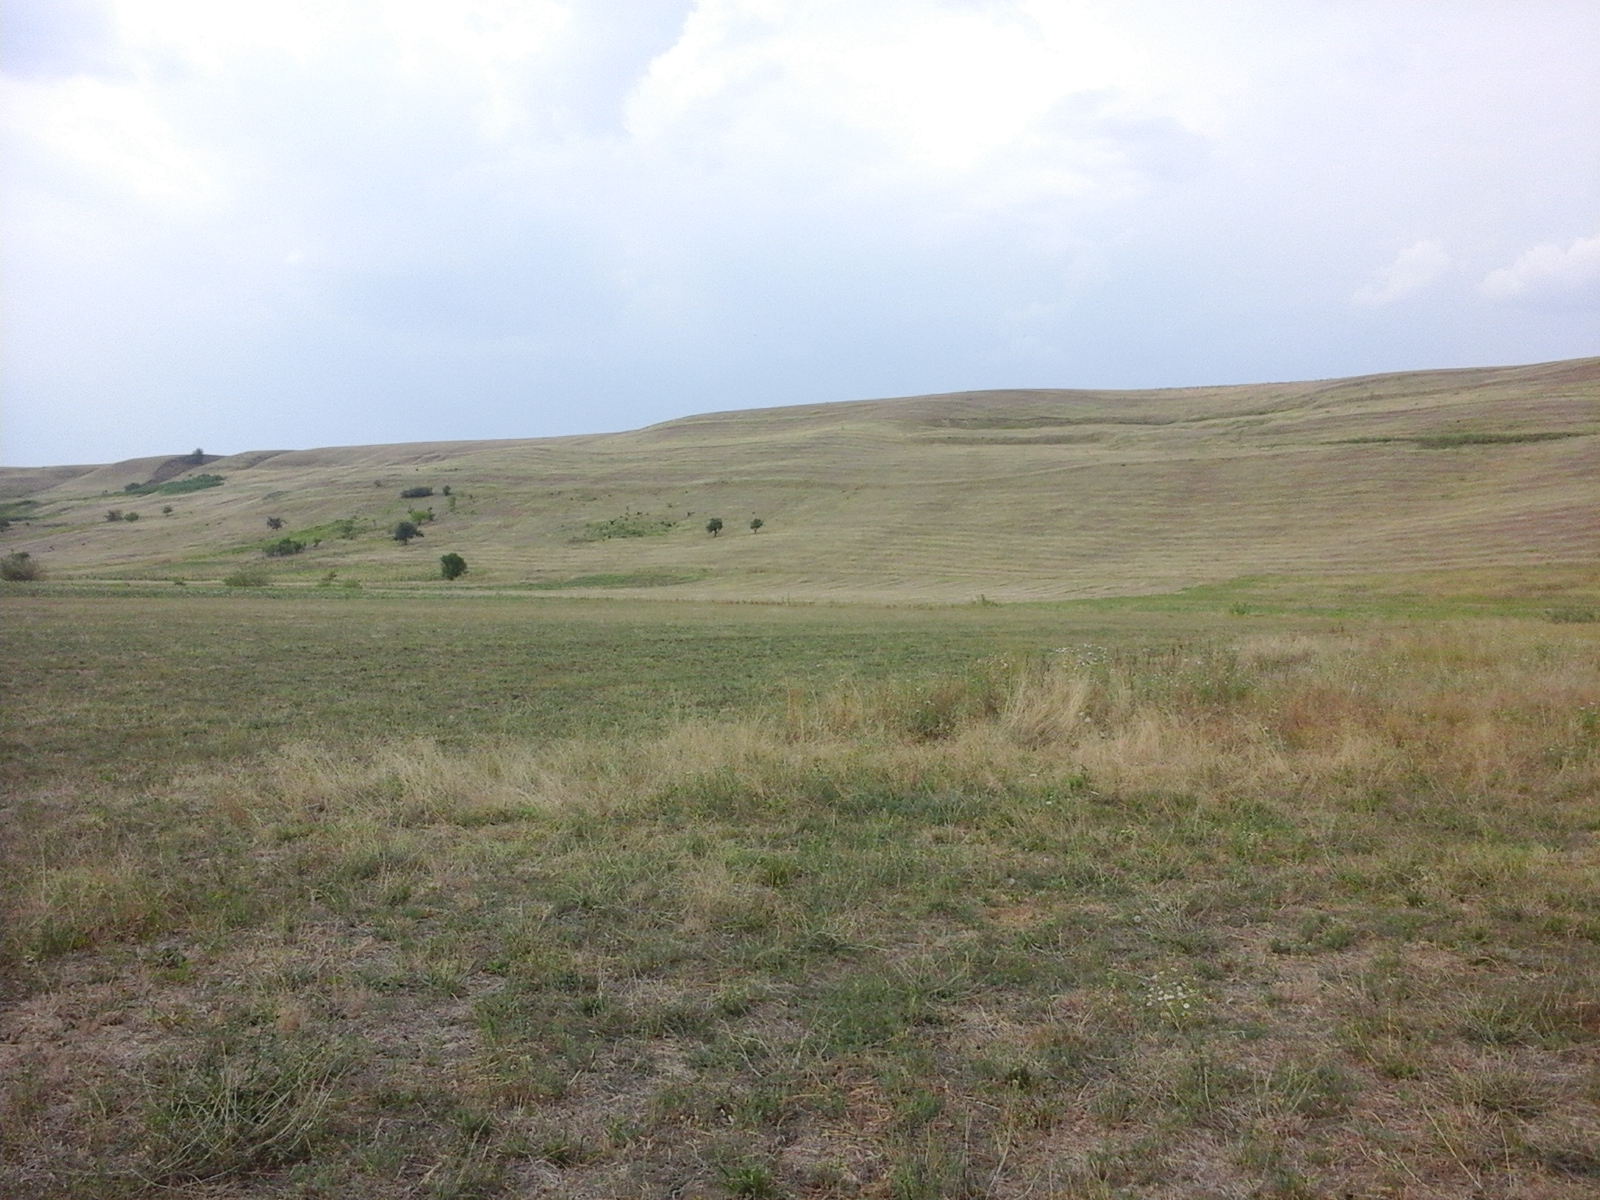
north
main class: Grassland
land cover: Grassland without tree/shrub cover
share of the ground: > 75 %
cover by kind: herbaceous plants 100 %
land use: Agriculture (excluding fallow land and kitchen gardens)
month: August
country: RO
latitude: 44.2972
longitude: 23.2710
